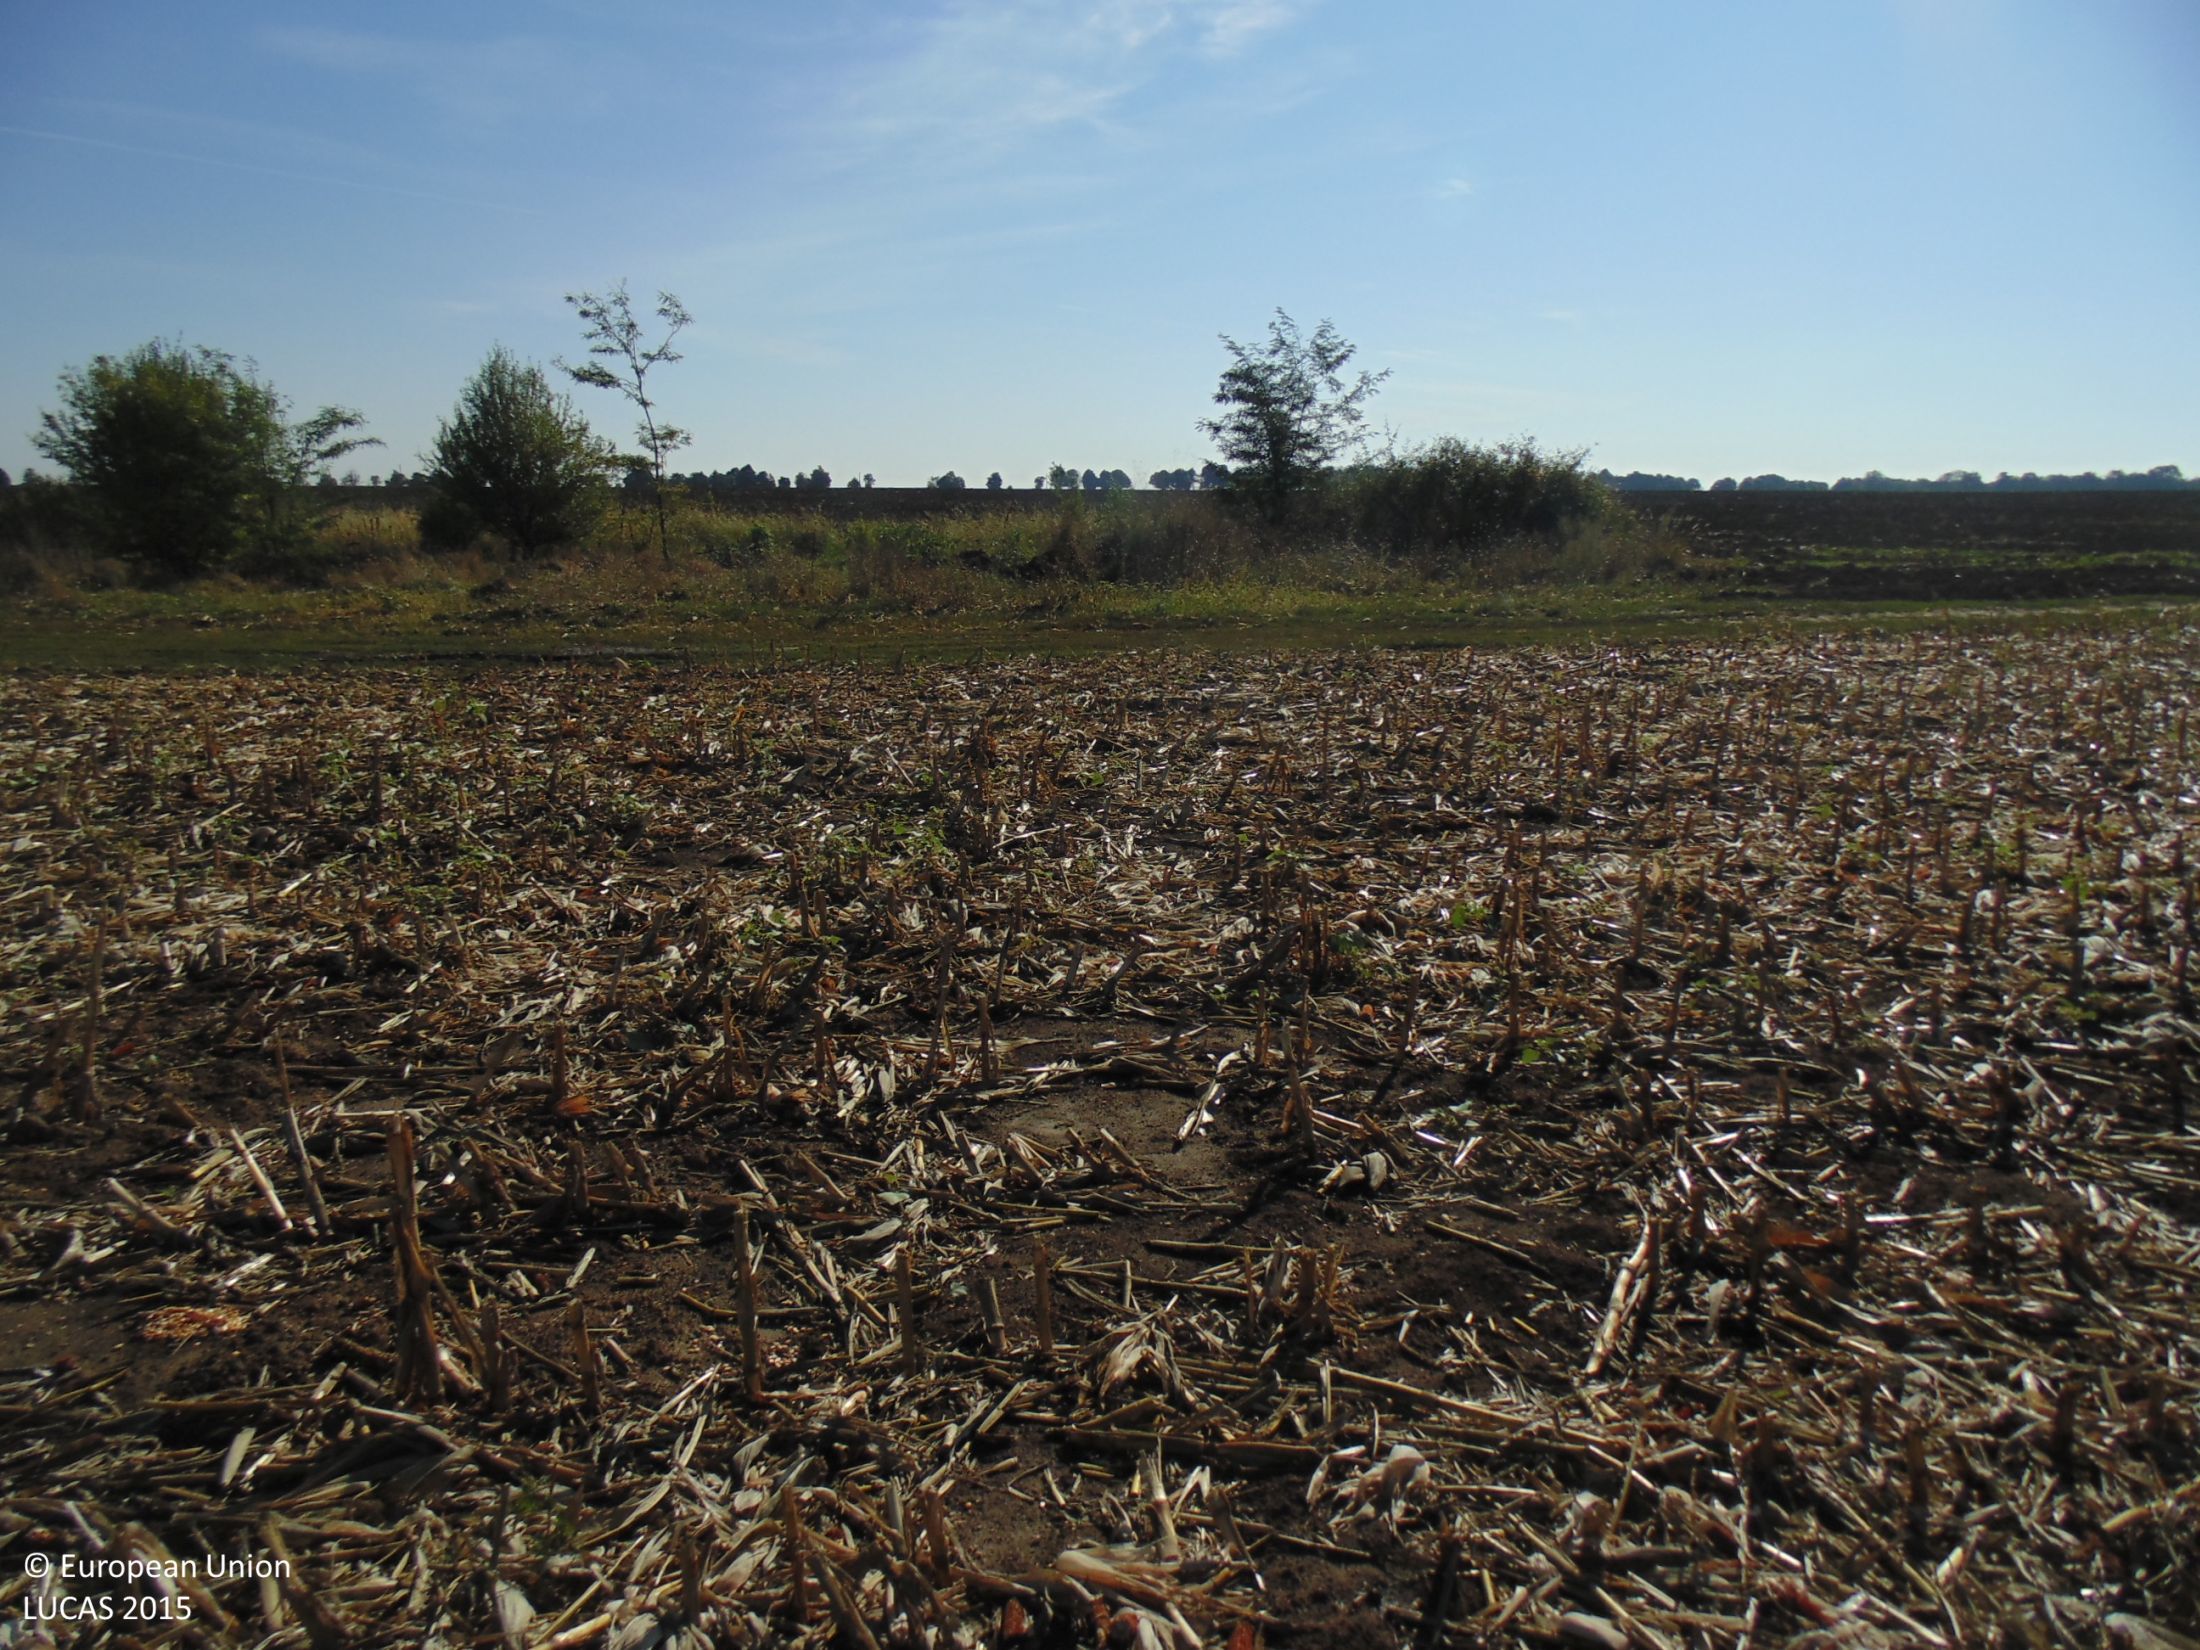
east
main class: Cropland
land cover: Maize
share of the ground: 10 - 25 %
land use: Agriculture (excluding fallow land and kitchen gardens)
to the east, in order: Maize; Tracks; Grassland with sparse tree/shrub cover; Common wheat
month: September
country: BG
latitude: 44.1080
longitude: 27.0291
